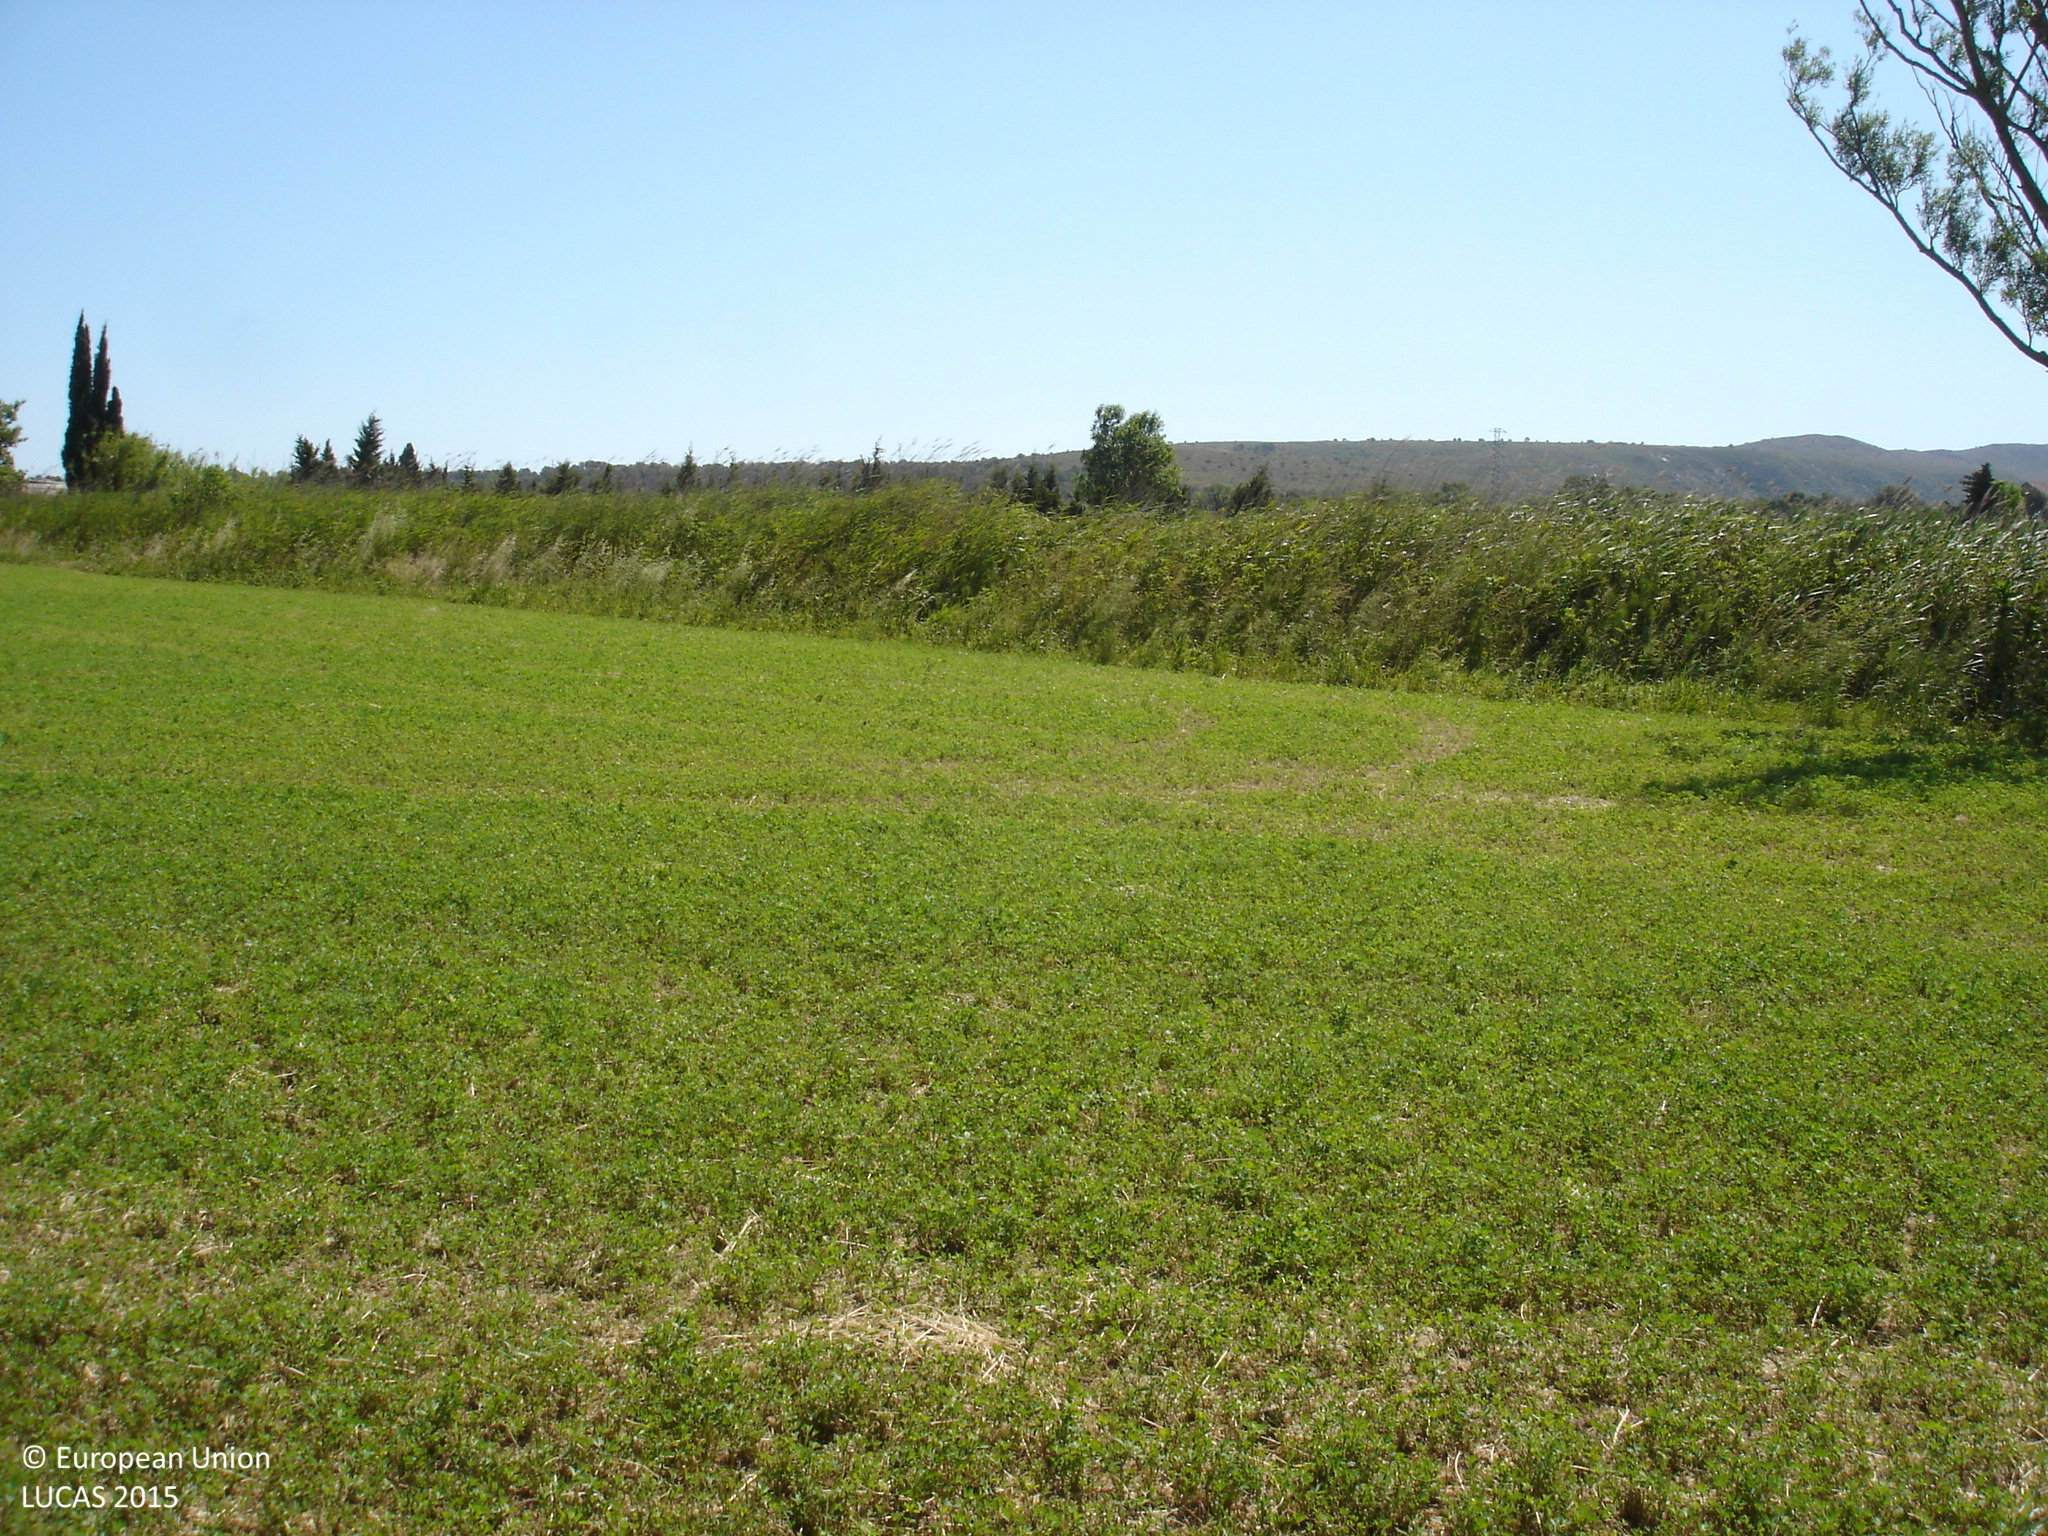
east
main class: Cropland
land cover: Lucerne
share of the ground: > 75 %
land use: Agriculture (excluding fallow land and kitchen gardens)
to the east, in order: Lucerne; Grass margins; Inland fresh running water; Grass margins; Tracks; Grass margins; Maize; Grass margins; Barley; Grass margins; Maize; Grass margins; Tracks; Grass margins; Abandoned hedges; Fences; Artificial constructions in urban areas; Other fresh vegetables; Fences; Grass margins; Maize; Oats; Grass margins; Maize; Barley
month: May
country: ES
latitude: 42.0735
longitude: 3.0897
